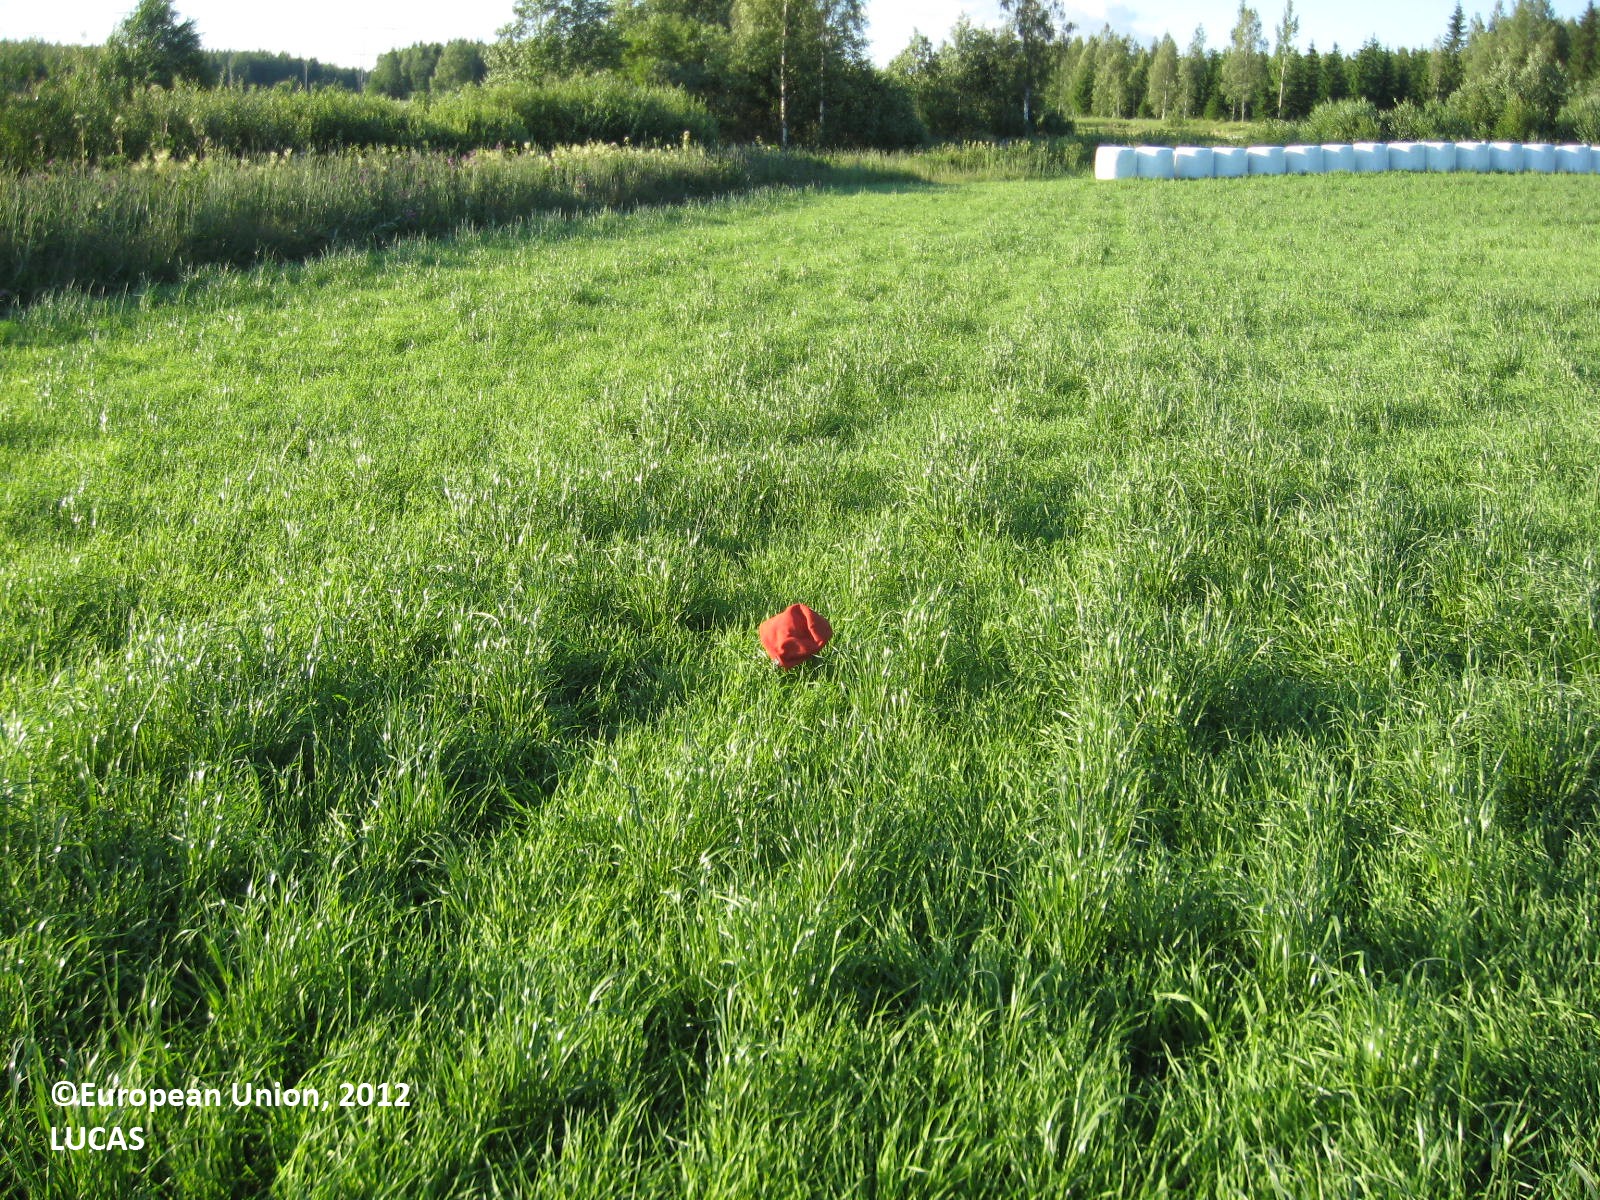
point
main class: Cropland
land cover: Temporary grasslands
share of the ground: > 75 %
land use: Agriculture (excluding fallow land and kitchen gardens)
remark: Harvested field
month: July
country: FI
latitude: 62.3795
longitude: 21.6271
